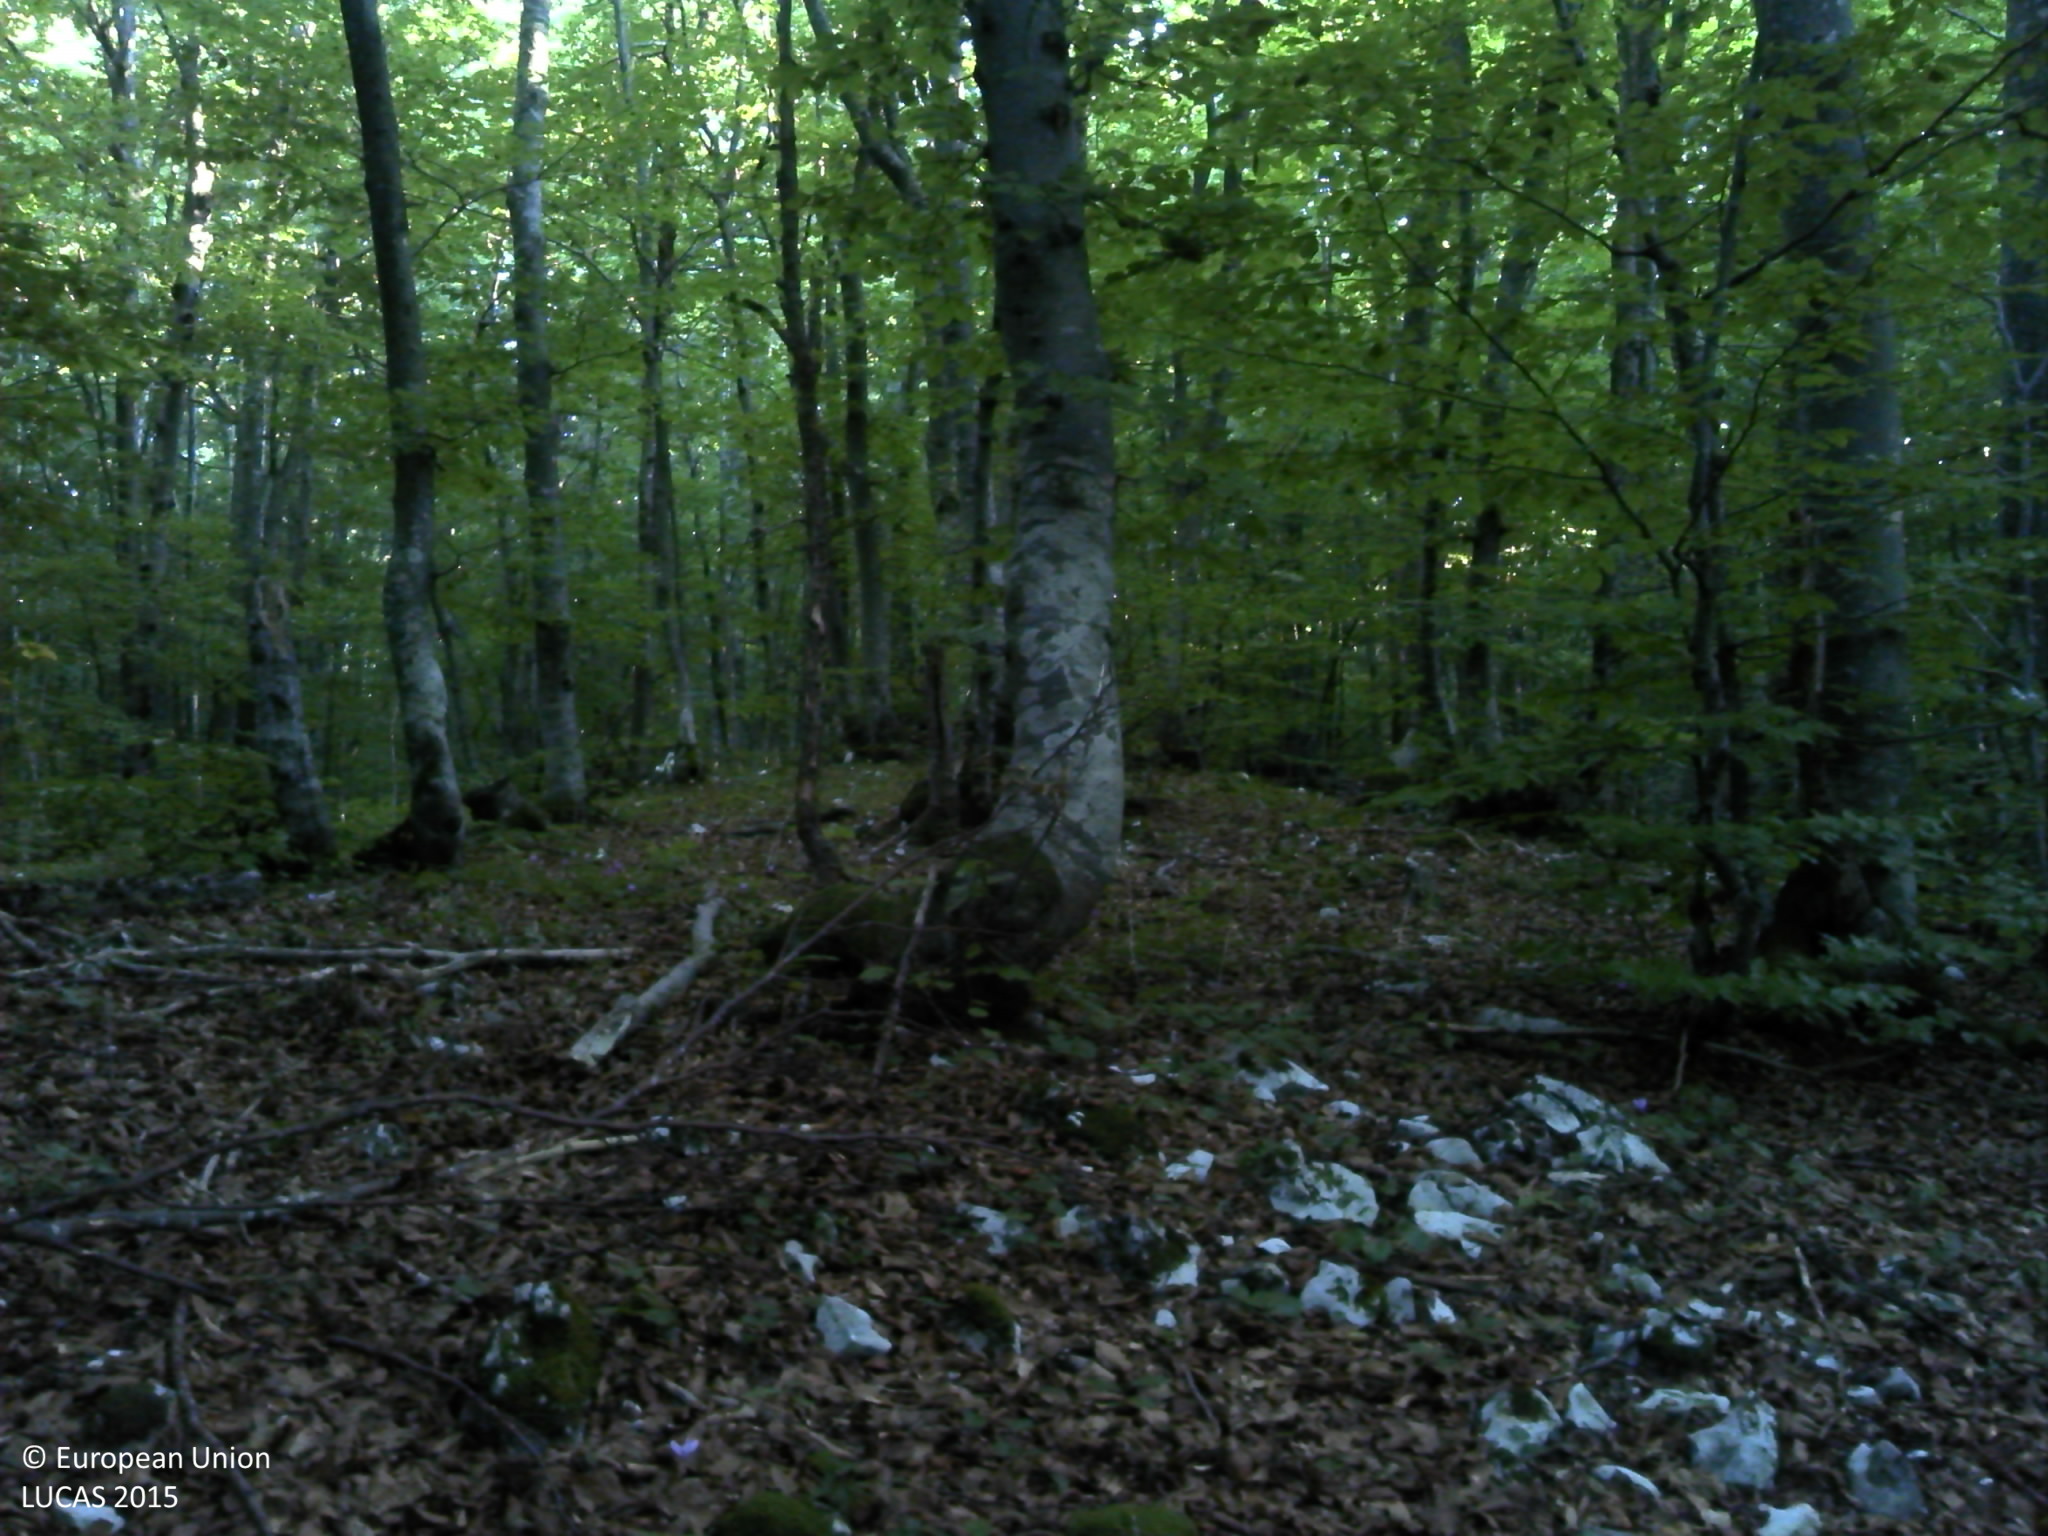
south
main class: Woodland
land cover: Broadleaved woodland
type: beech forest
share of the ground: > 75 %
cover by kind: broadleaved forest trees 90 %, lichens and mosses 5 %, consolidated bare surface 5 %
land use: Forestry
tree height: > 5 m
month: August
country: HR
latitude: 44.9012
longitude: 15.6556
